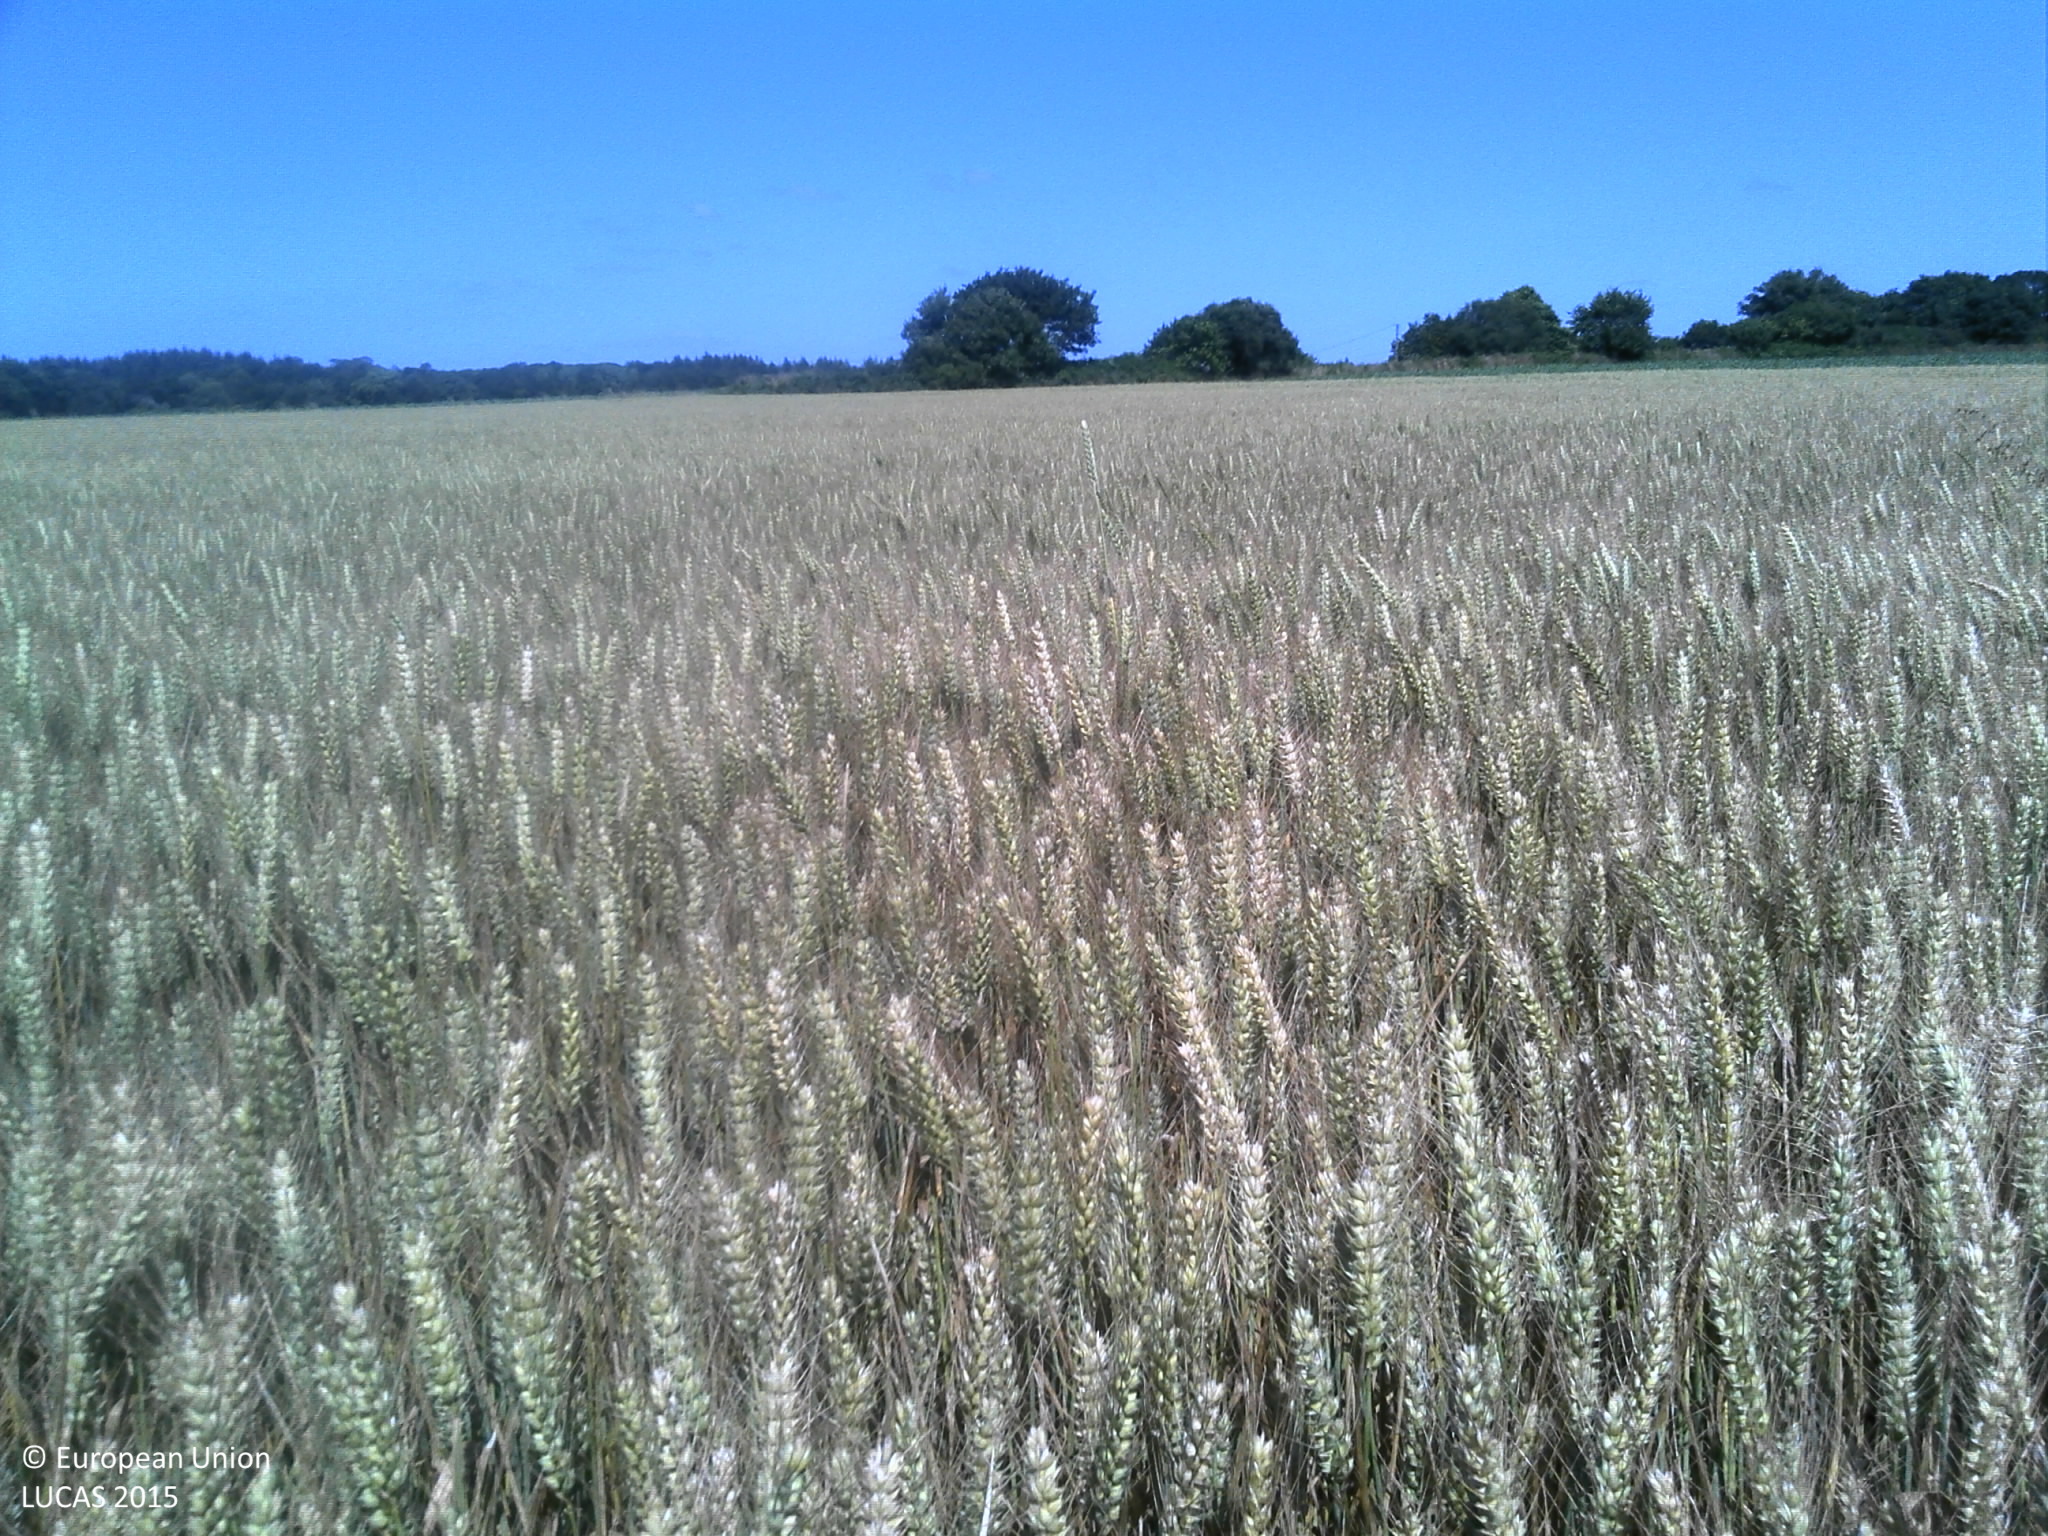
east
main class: Cropland
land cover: Common wheat
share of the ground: > 75 %
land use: Agriculture (excluding fallow land and kitchen gardens)
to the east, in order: Common wheat; Tracks; Maize; Managed hedges; Maize; Conifer hedges; Electric lines; Paved roads, cycling and walking lanes
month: July
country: FR
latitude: 48.6311
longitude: -3.7756
